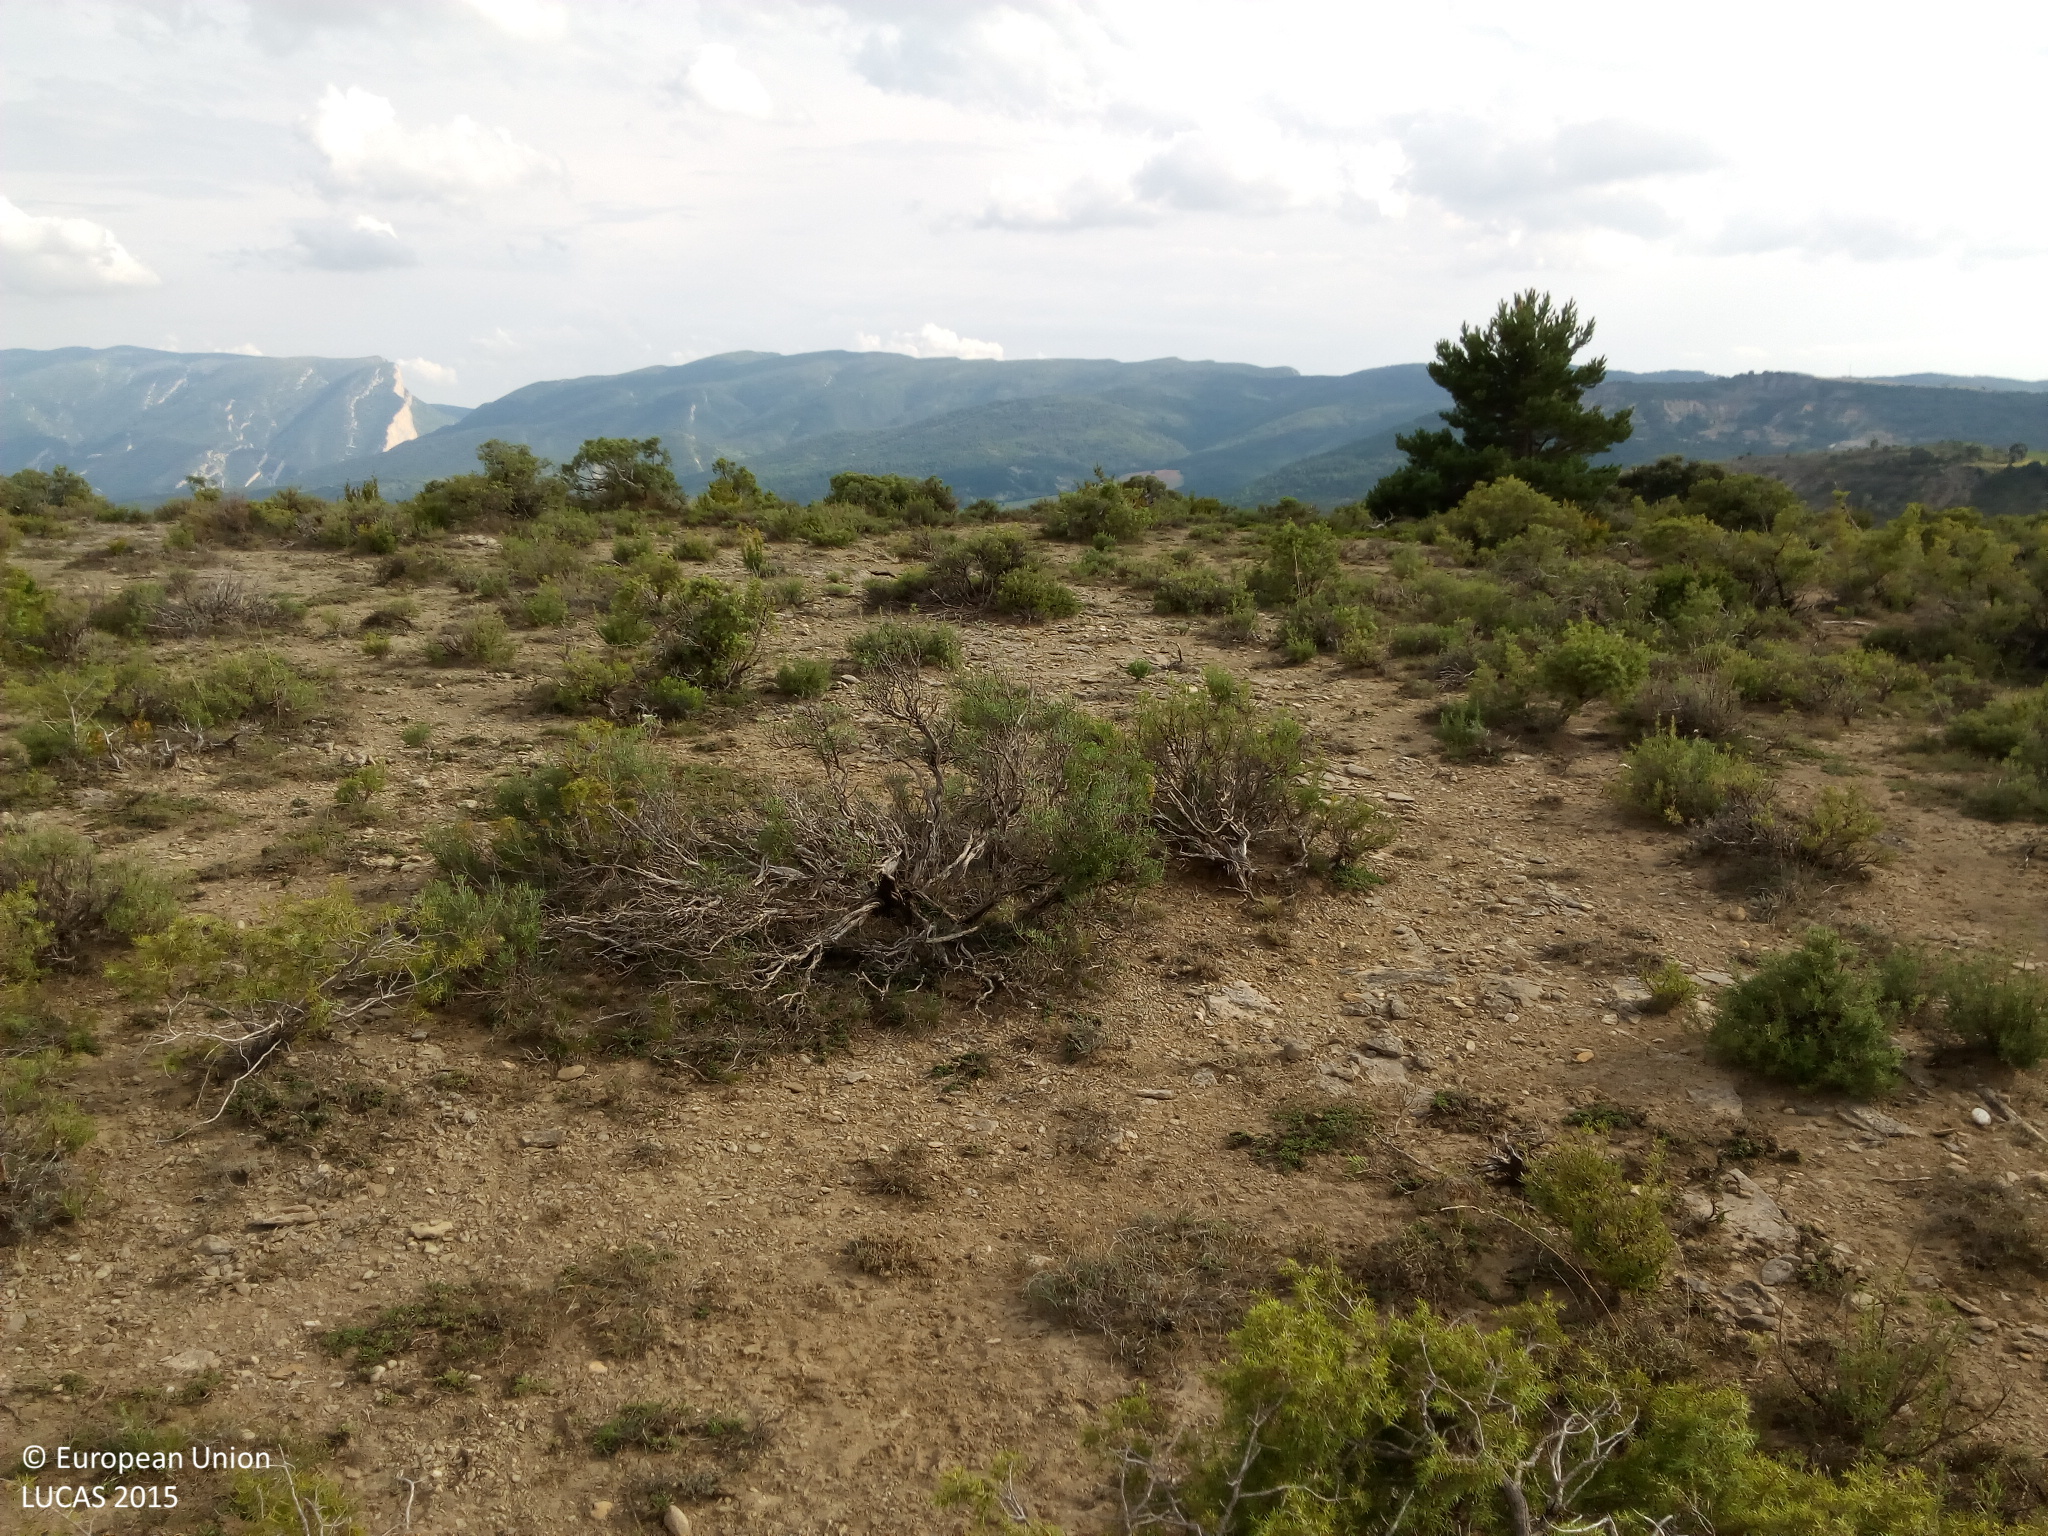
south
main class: Shrubland
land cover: Shrubland with sparse tree cover
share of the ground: > 75 %
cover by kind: shrubs 45 %, herbaceous plants 20 %, unconsolidated bare surface 20 %, consolidated bare surface 10 %, broadleaved forest trees 5 %
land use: Semi-natural and natural areas not in use
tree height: < 5 m
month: August
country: ES
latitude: 42.1461
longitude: 0.6299
